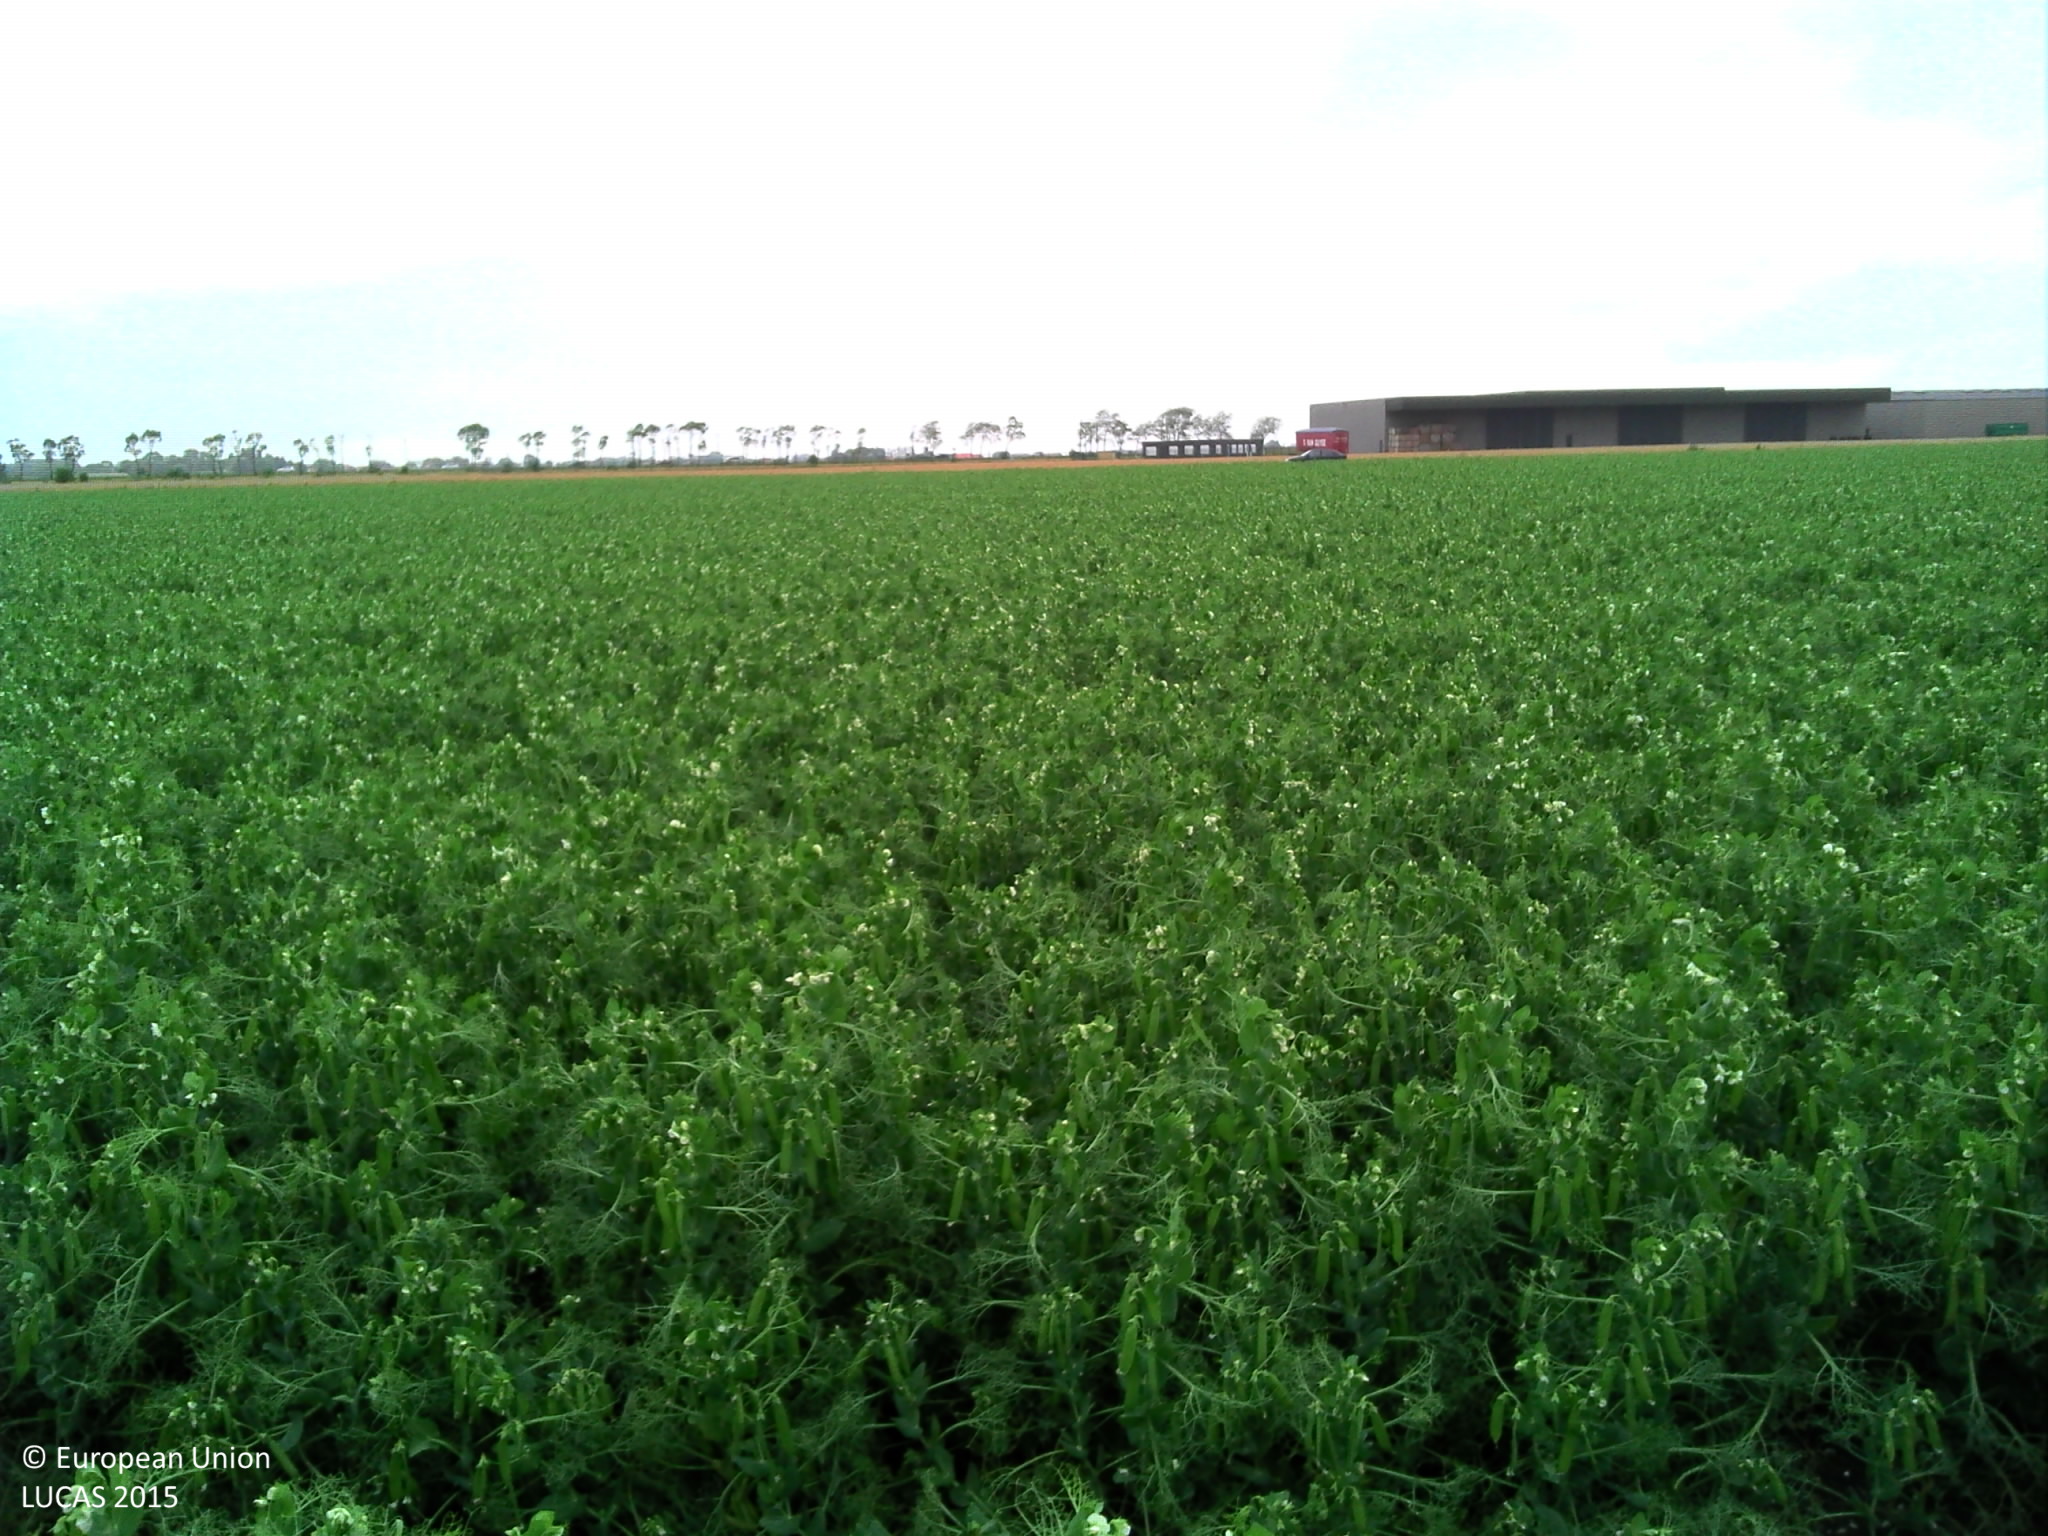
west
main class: Cropland
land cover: Dry pulses
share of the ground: > 75 %
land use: Agriculture (excluding fallow land and kitchen gardens)
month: July
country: FR
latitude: 50.9306
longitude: 2.2311
